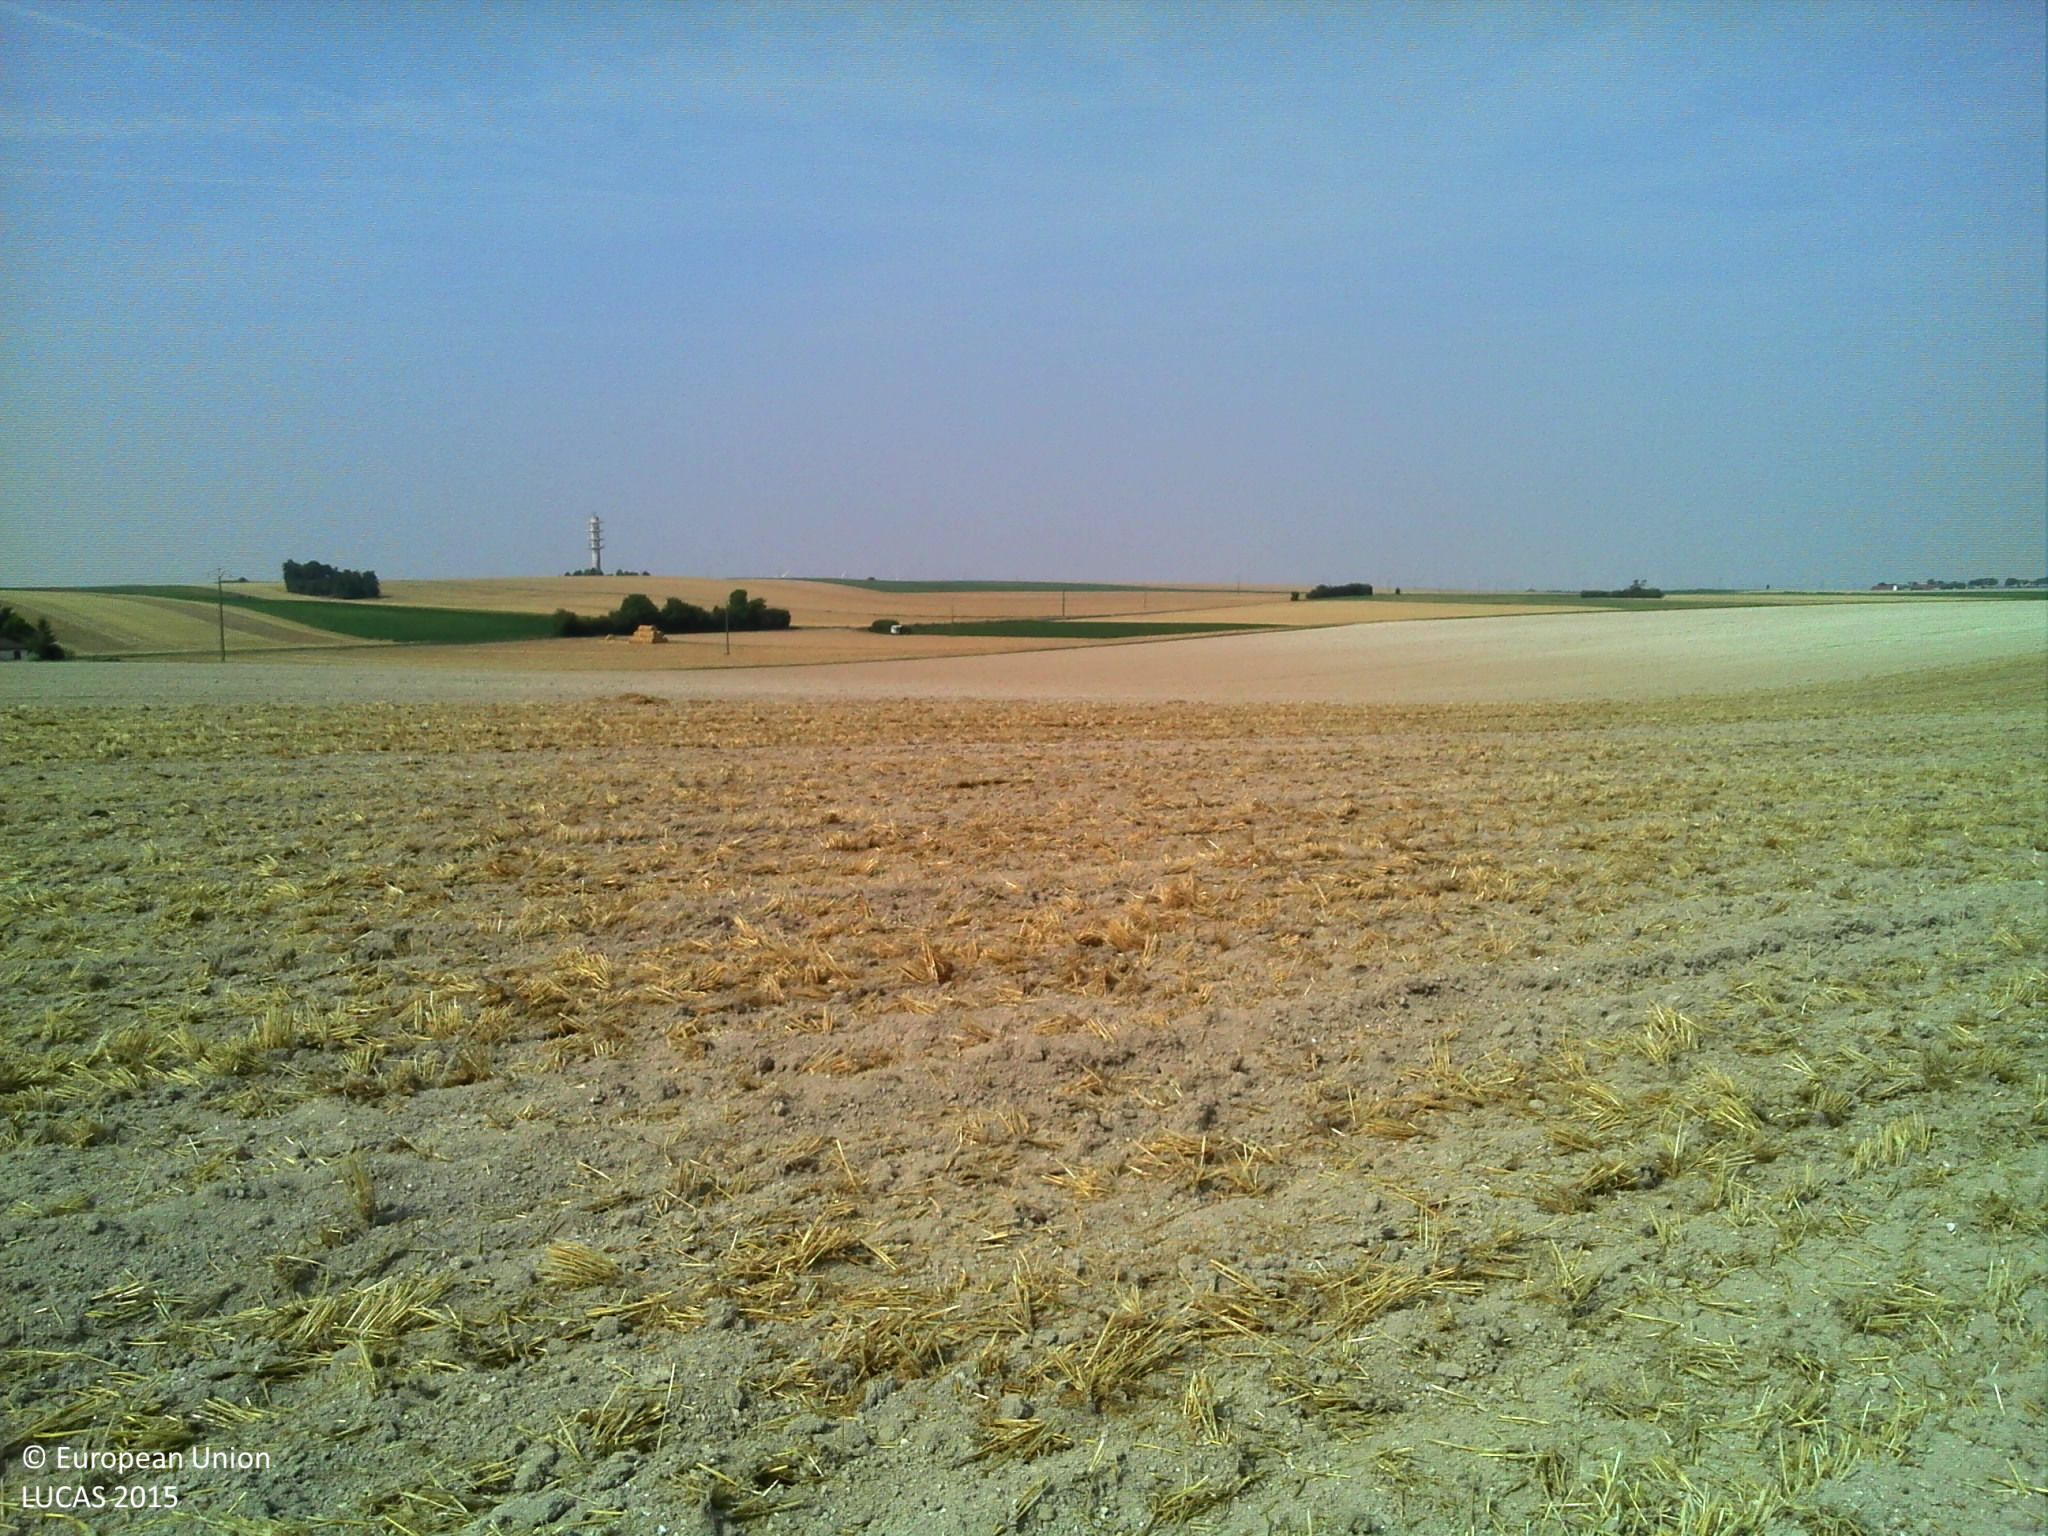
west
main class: Cropland
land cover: Common wheat
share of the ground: > 75 %
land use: Agriculture (excluding fallow land and kitchen gardens)
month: August
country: FR
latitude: 48.7170
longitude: 4.1378
